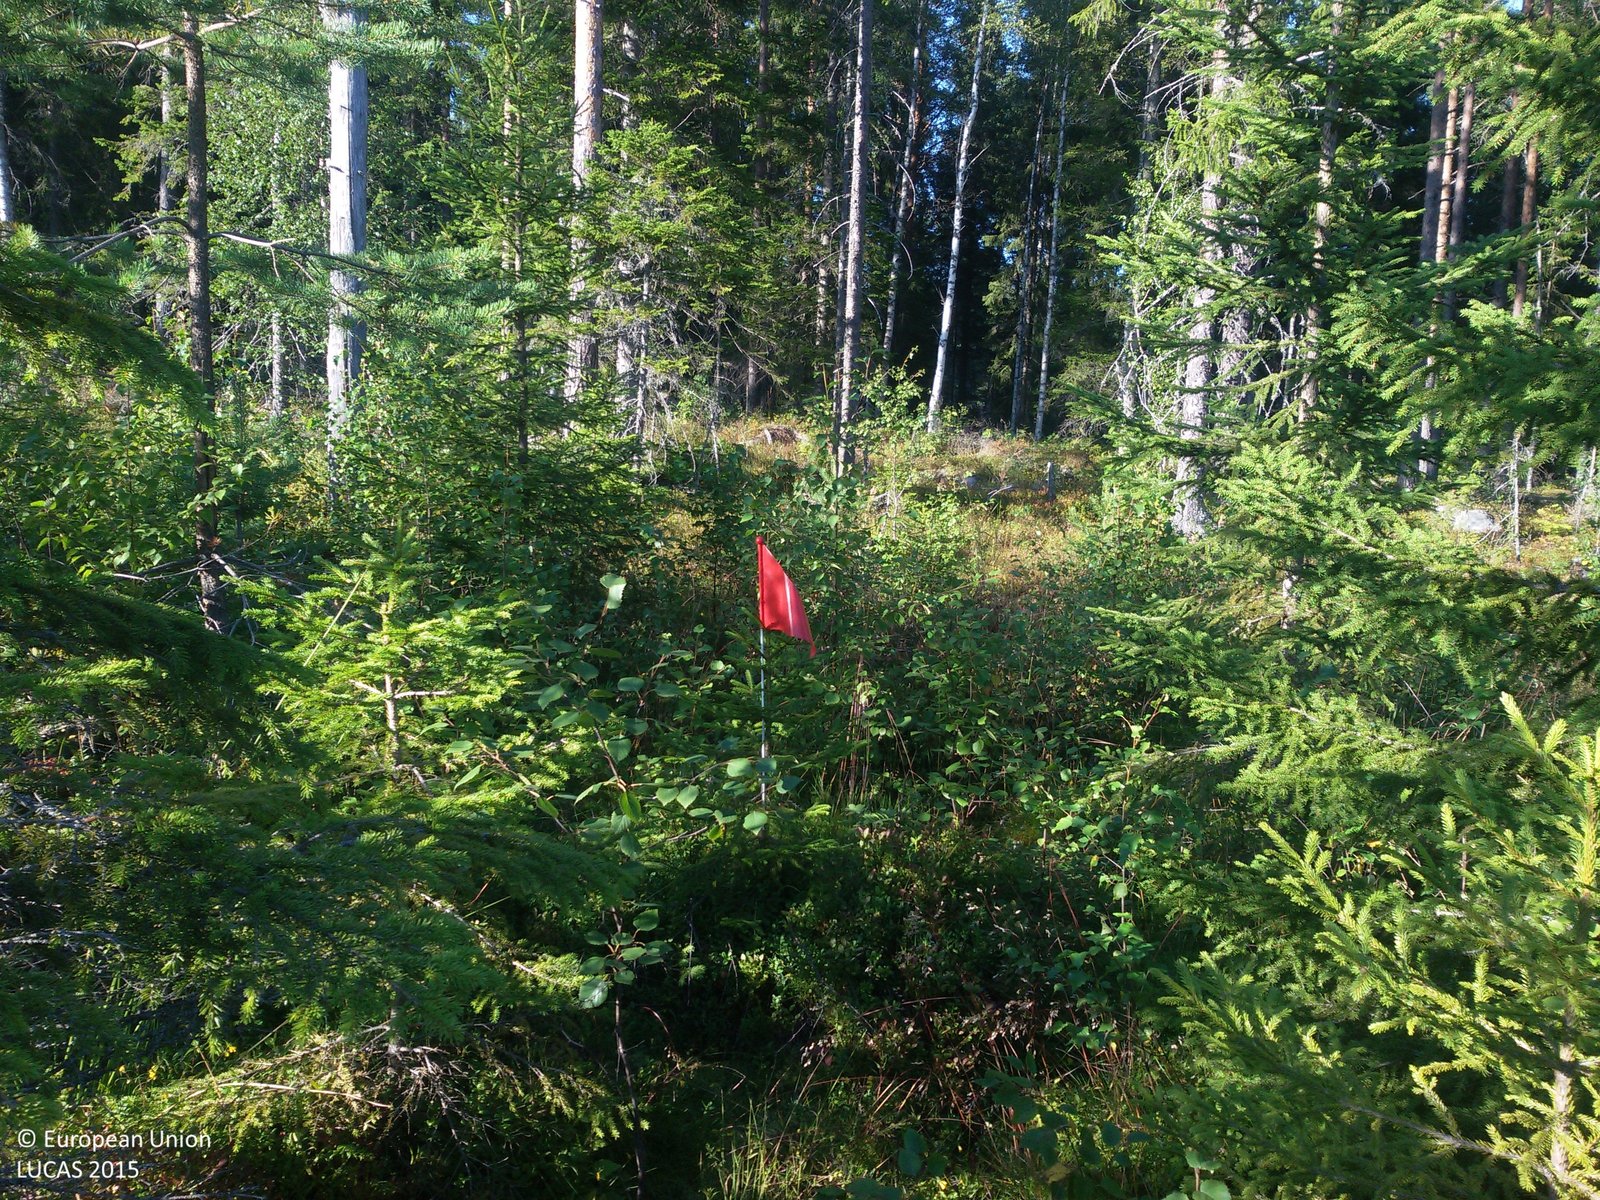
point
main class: Woodland
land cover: Spruce dominated mixed woodland
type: boreal forest
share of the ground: 50 - 75 %
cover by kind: coniferous forest trees 40 %, broadleaved forest trees 25 %, lichens and mosses 15 %, shrubs 10 %, herbaceous plants 10 %
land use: Forestry
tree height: < 5 m
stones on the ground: < 10 %
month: August
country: SE
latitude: 60.7912
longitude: 16.4720
